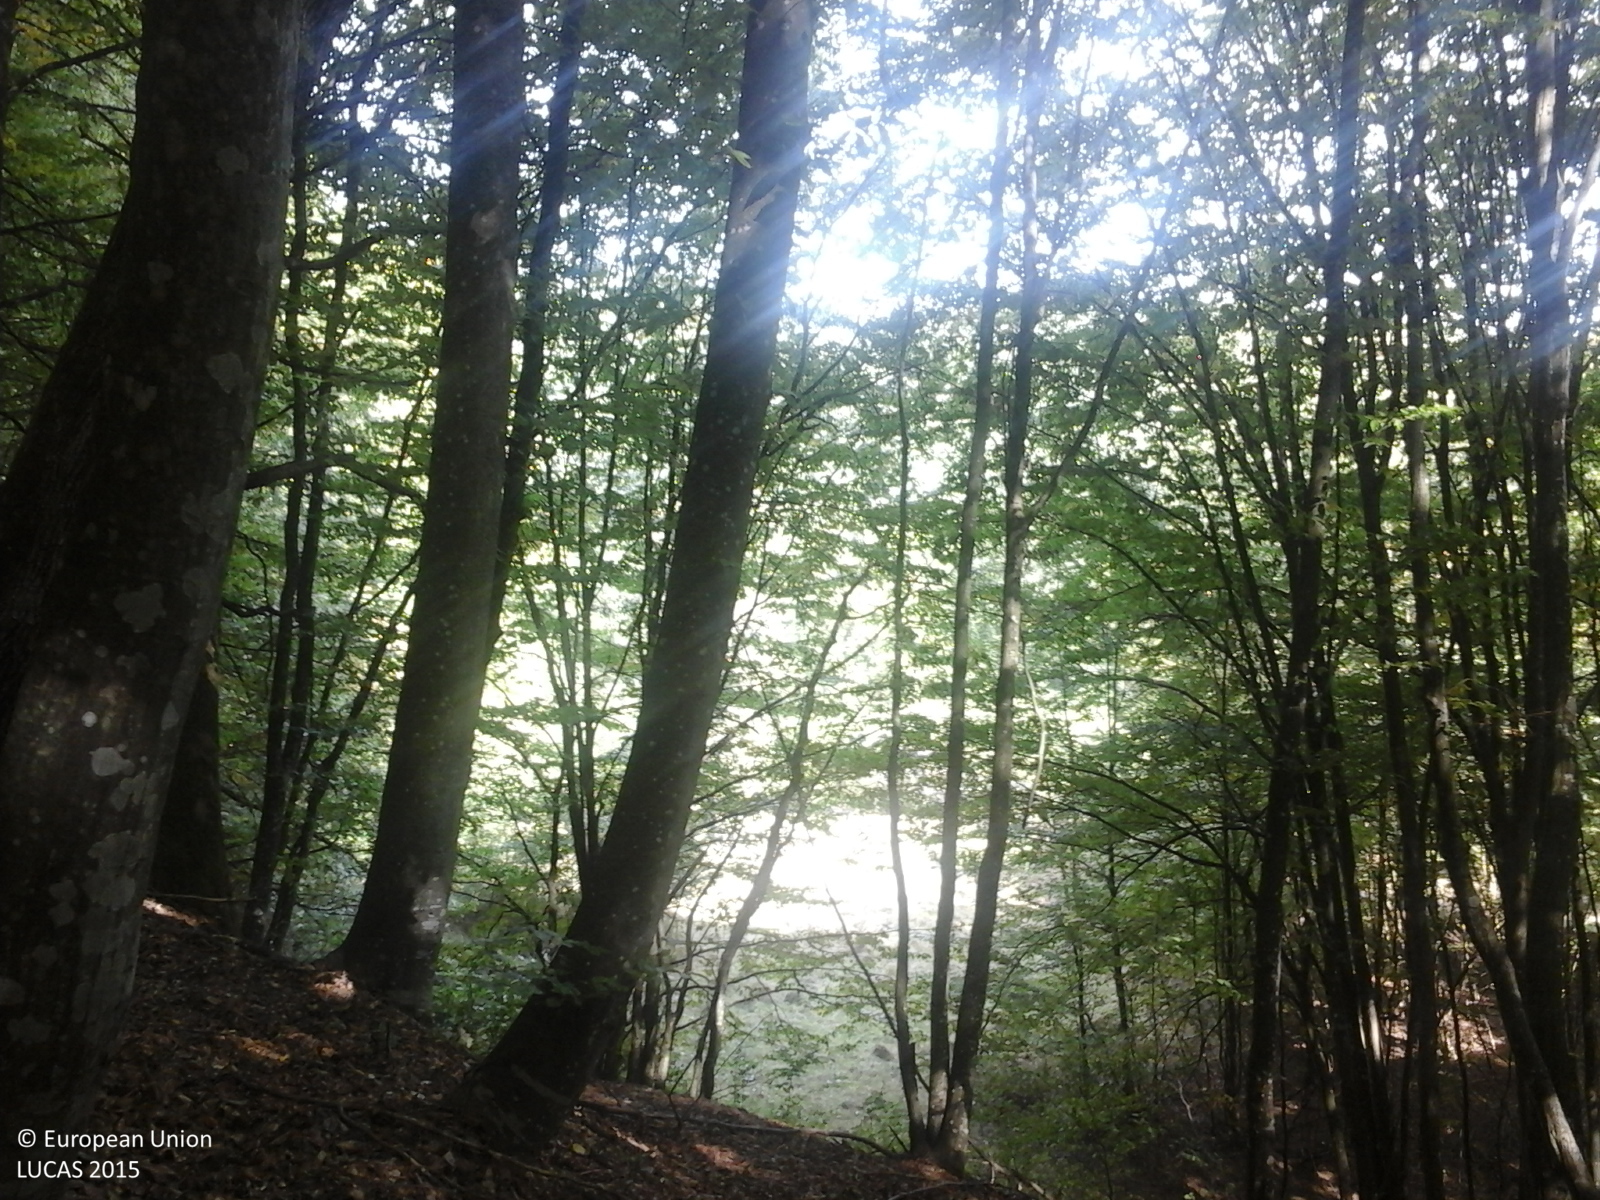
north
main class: Woodland
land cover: Broadleaved woodland
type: beech forest
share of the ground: > 75 %
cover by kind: broadleaved forest trees 100 %
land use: Forestry
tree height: > 5 m
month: September
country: RO
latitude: 47.2924
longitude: 23.6827
